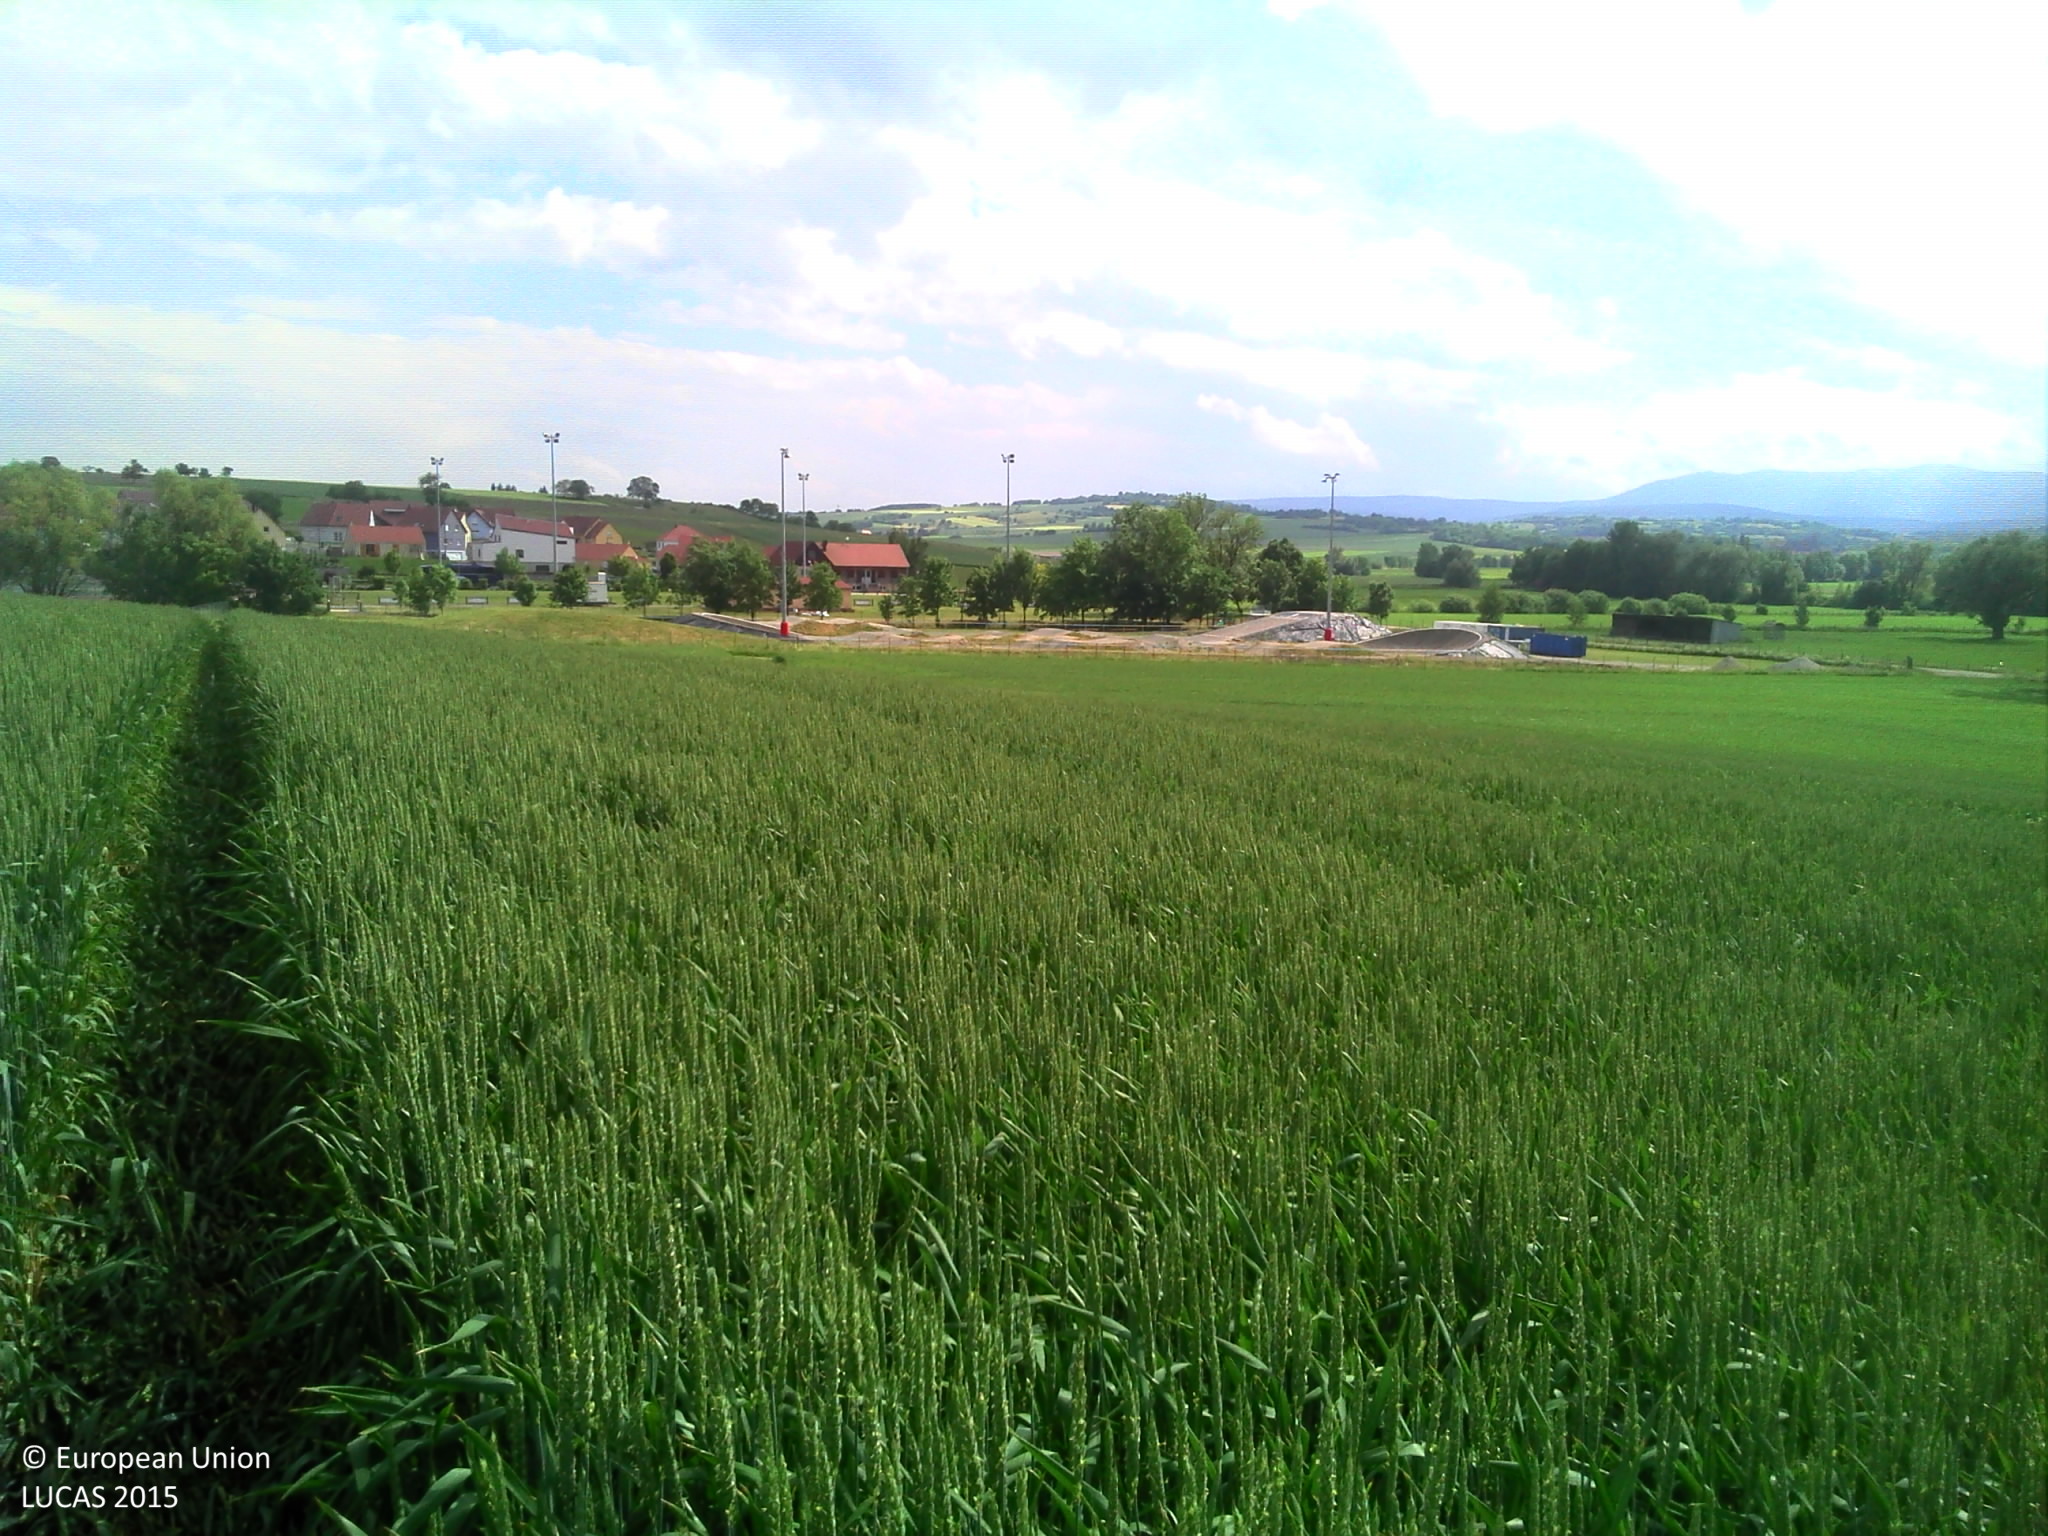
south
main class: Cropland
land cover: Common wheat
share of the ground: > 75 %
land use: Agriculture (excluding fallow land and kitchen gardens)
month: May
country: FR
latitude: 48.7151
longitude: 7.4048
